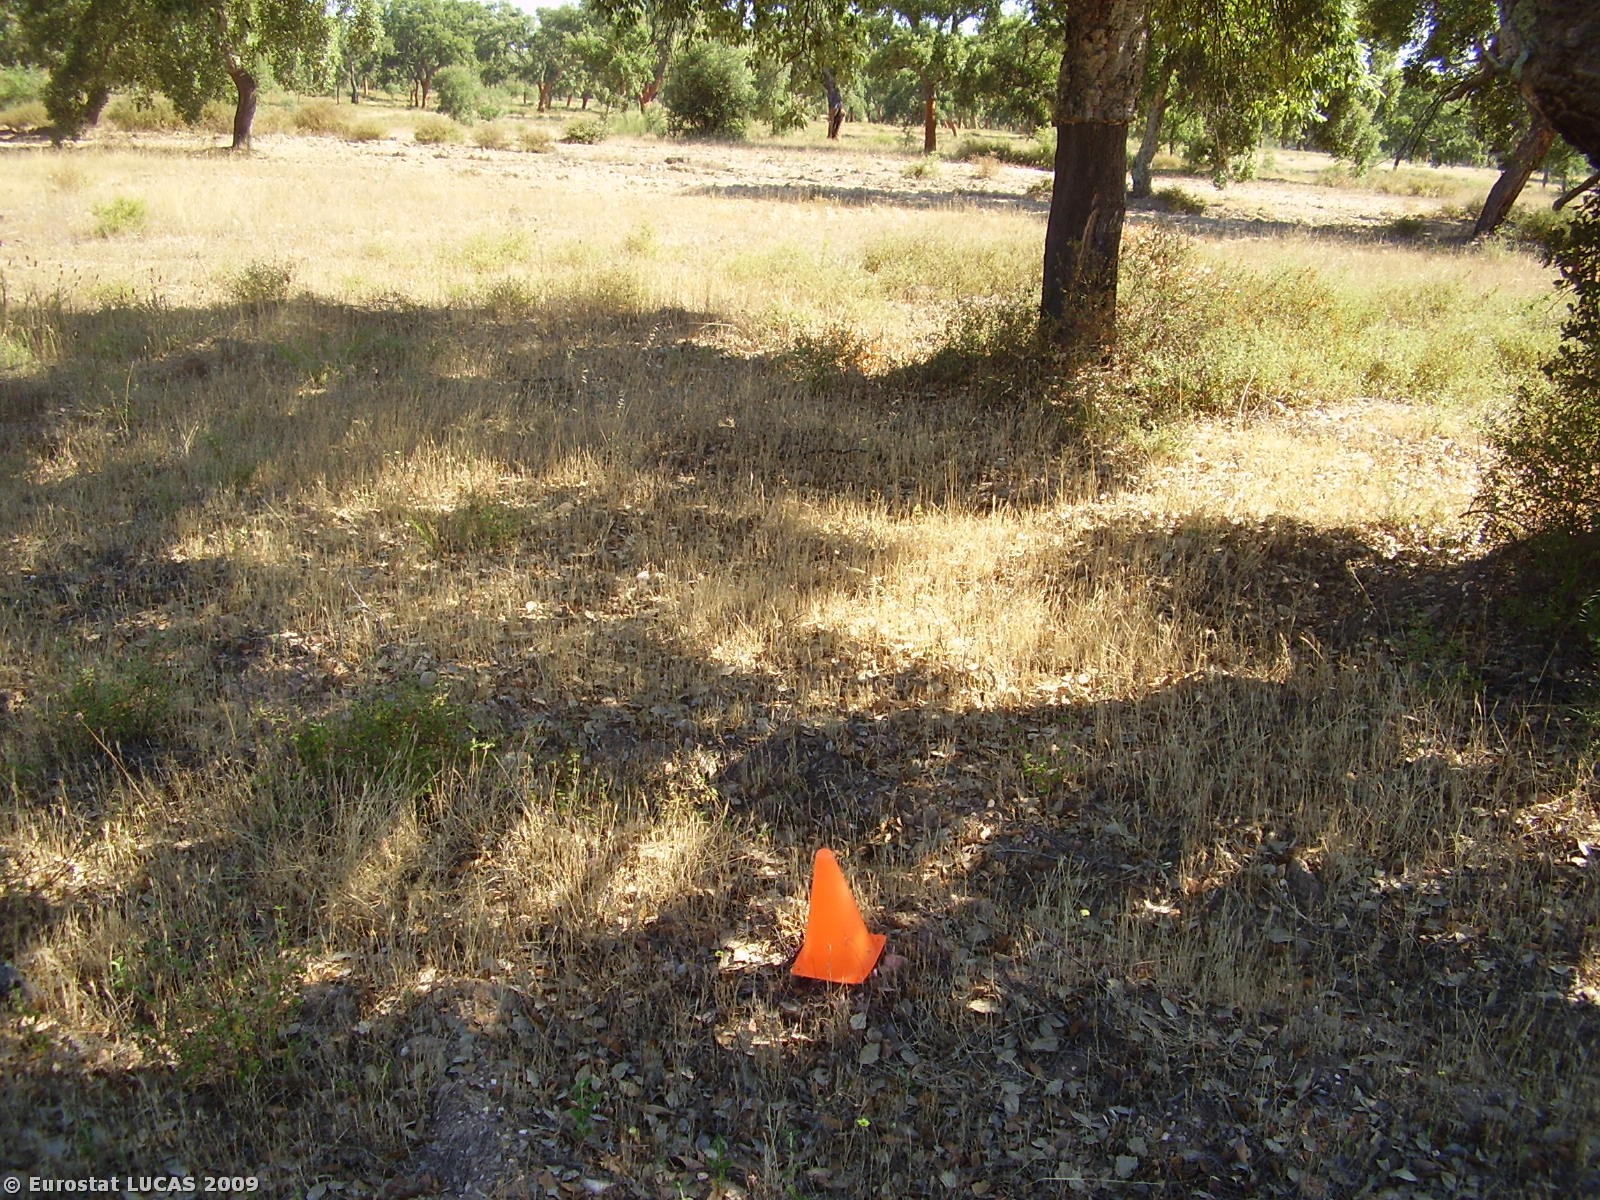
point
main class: Woodland
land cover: Broadleaved woodland
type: broadleaved evergreen forest
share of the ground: < 10 %
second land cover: Spontaneously vegetated surfaces
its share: > 75 %
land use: Forestry
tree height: > 5 m
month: July
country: PT
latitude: 39.3530
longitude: -8.1519
